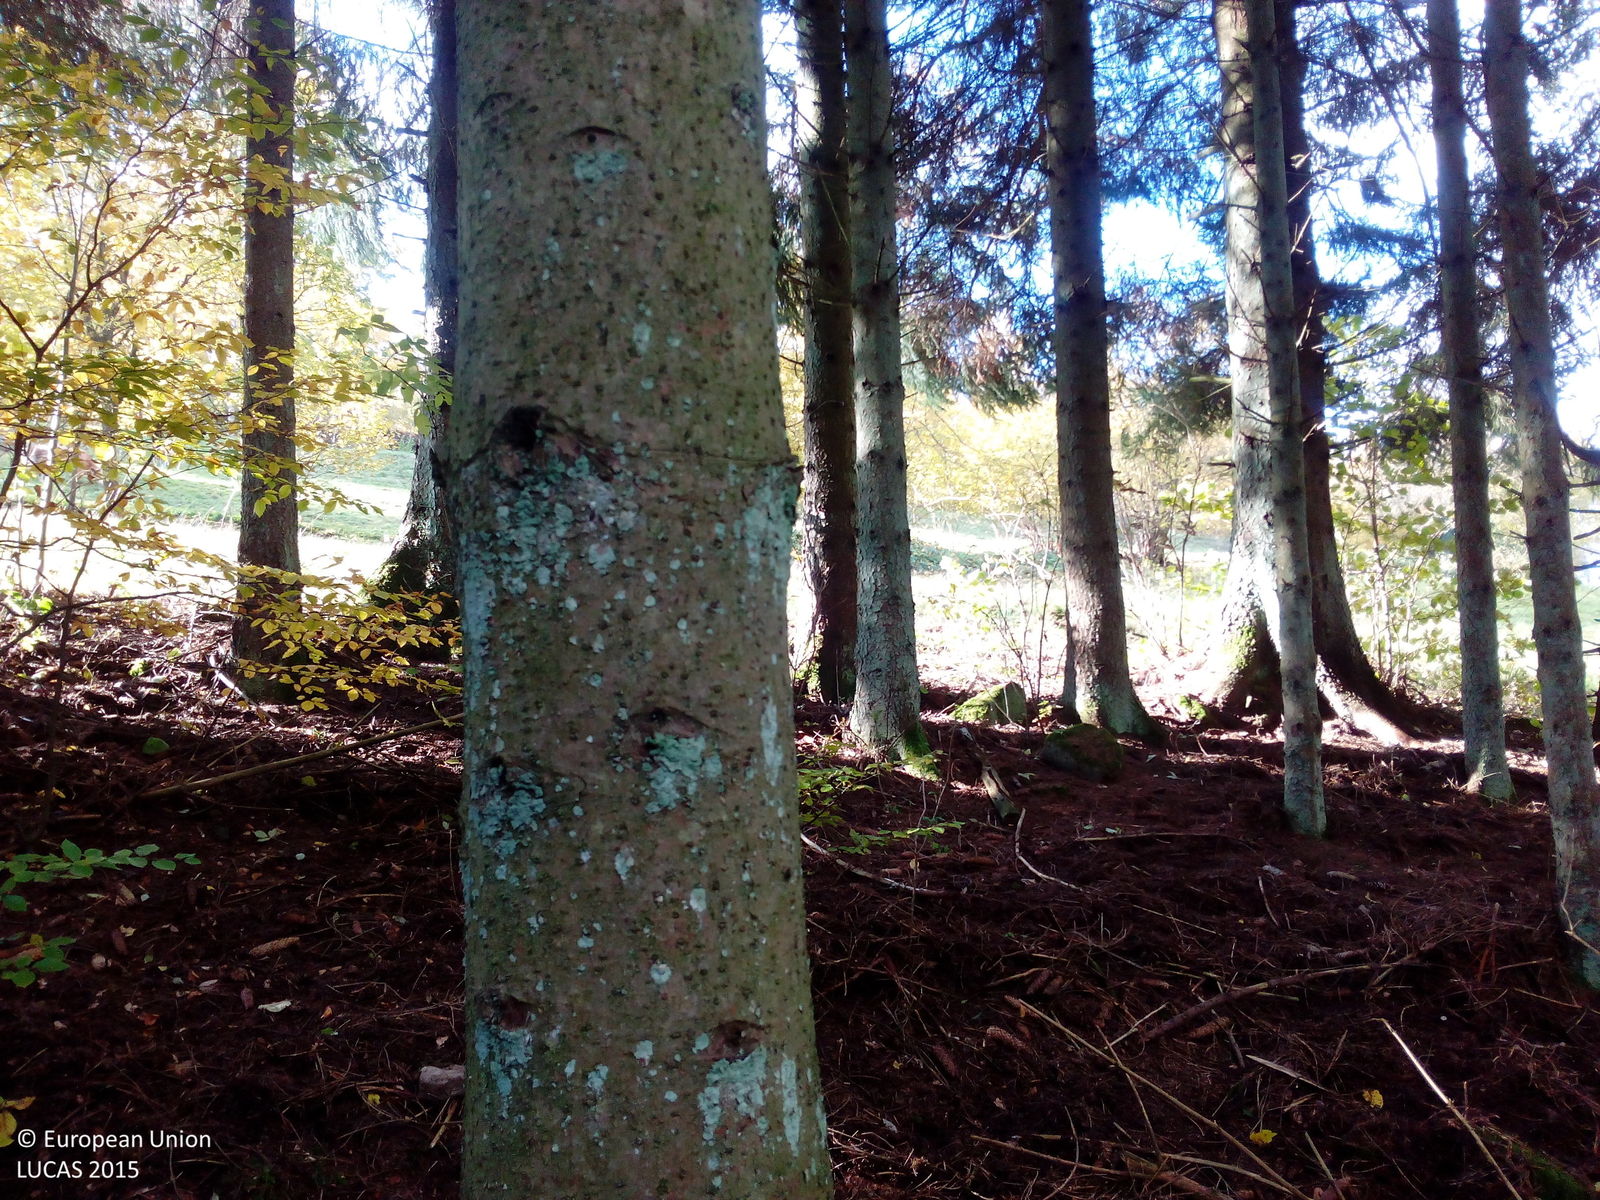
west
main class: Woodland
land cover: Spruce dominated coniferous woodland
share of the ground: 50 - 75 %
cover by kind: coniferous forest trees 65 %, unconsolidated bare surface 15 %, lichens and mosses 10 %, broadleaved forest trees 5 %, shrubs 5 %
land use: Forestry
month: October
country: DE
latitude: 50.3460
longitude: 9.8736
